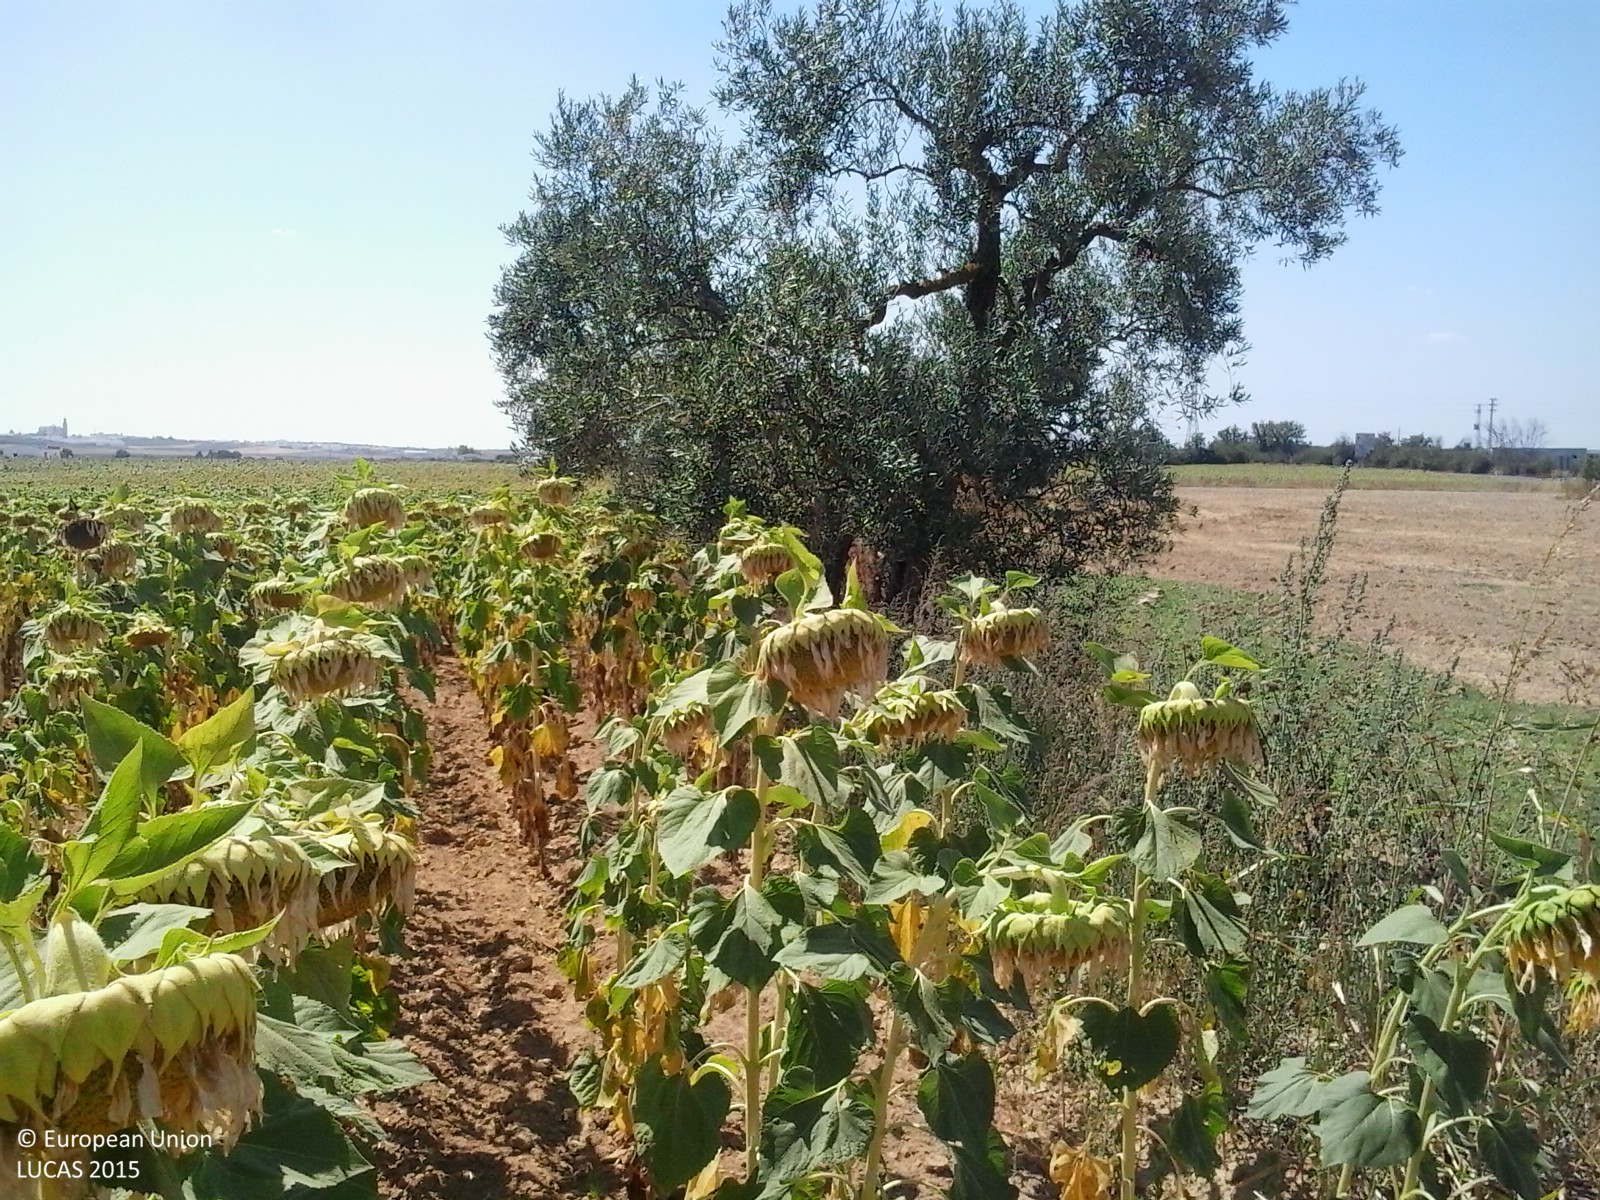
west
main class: Cropland
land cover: Sunflower
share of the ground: > 75 %
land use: Agriculture (excluding fallow land and kitchen gardens)
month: June
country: ES
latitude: 37.3843
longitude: -6.3957
